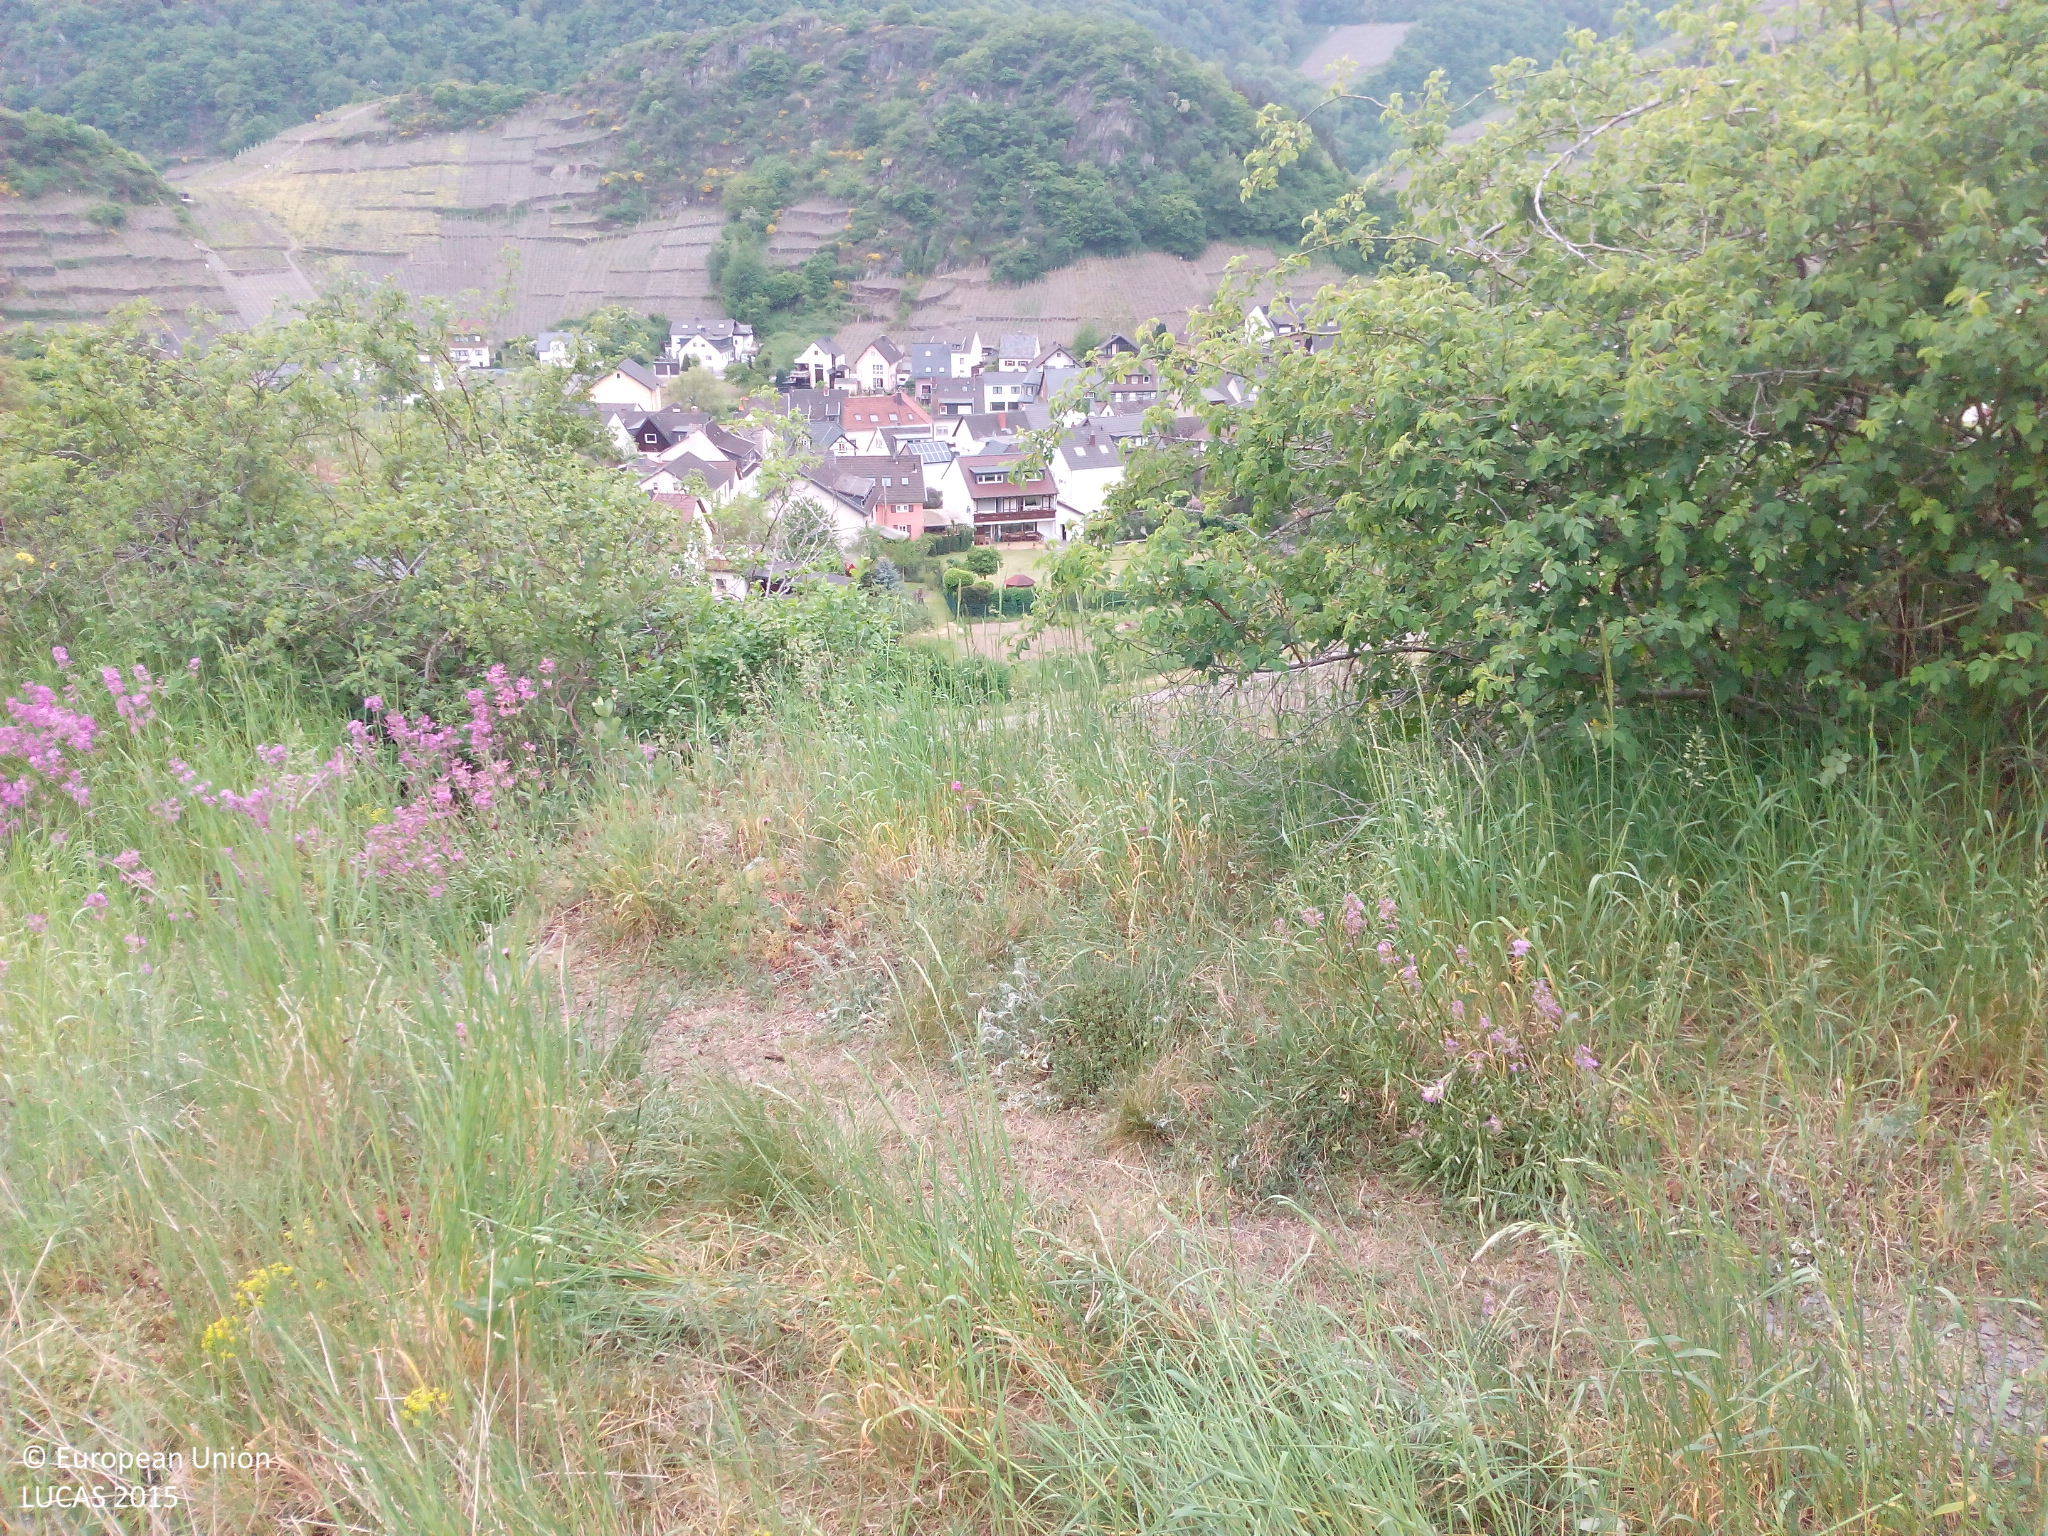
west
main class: Grassland
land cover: Grassland with sparse tree/shrub cover
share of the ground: > 75 %
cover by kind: herbaceous plants 85 %, shrubs 10 %, broadleaved forest trees 5 %
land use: Semi-natural and natural areas not in use
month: May
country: DE
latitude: 50.5233
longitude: 7.0238
